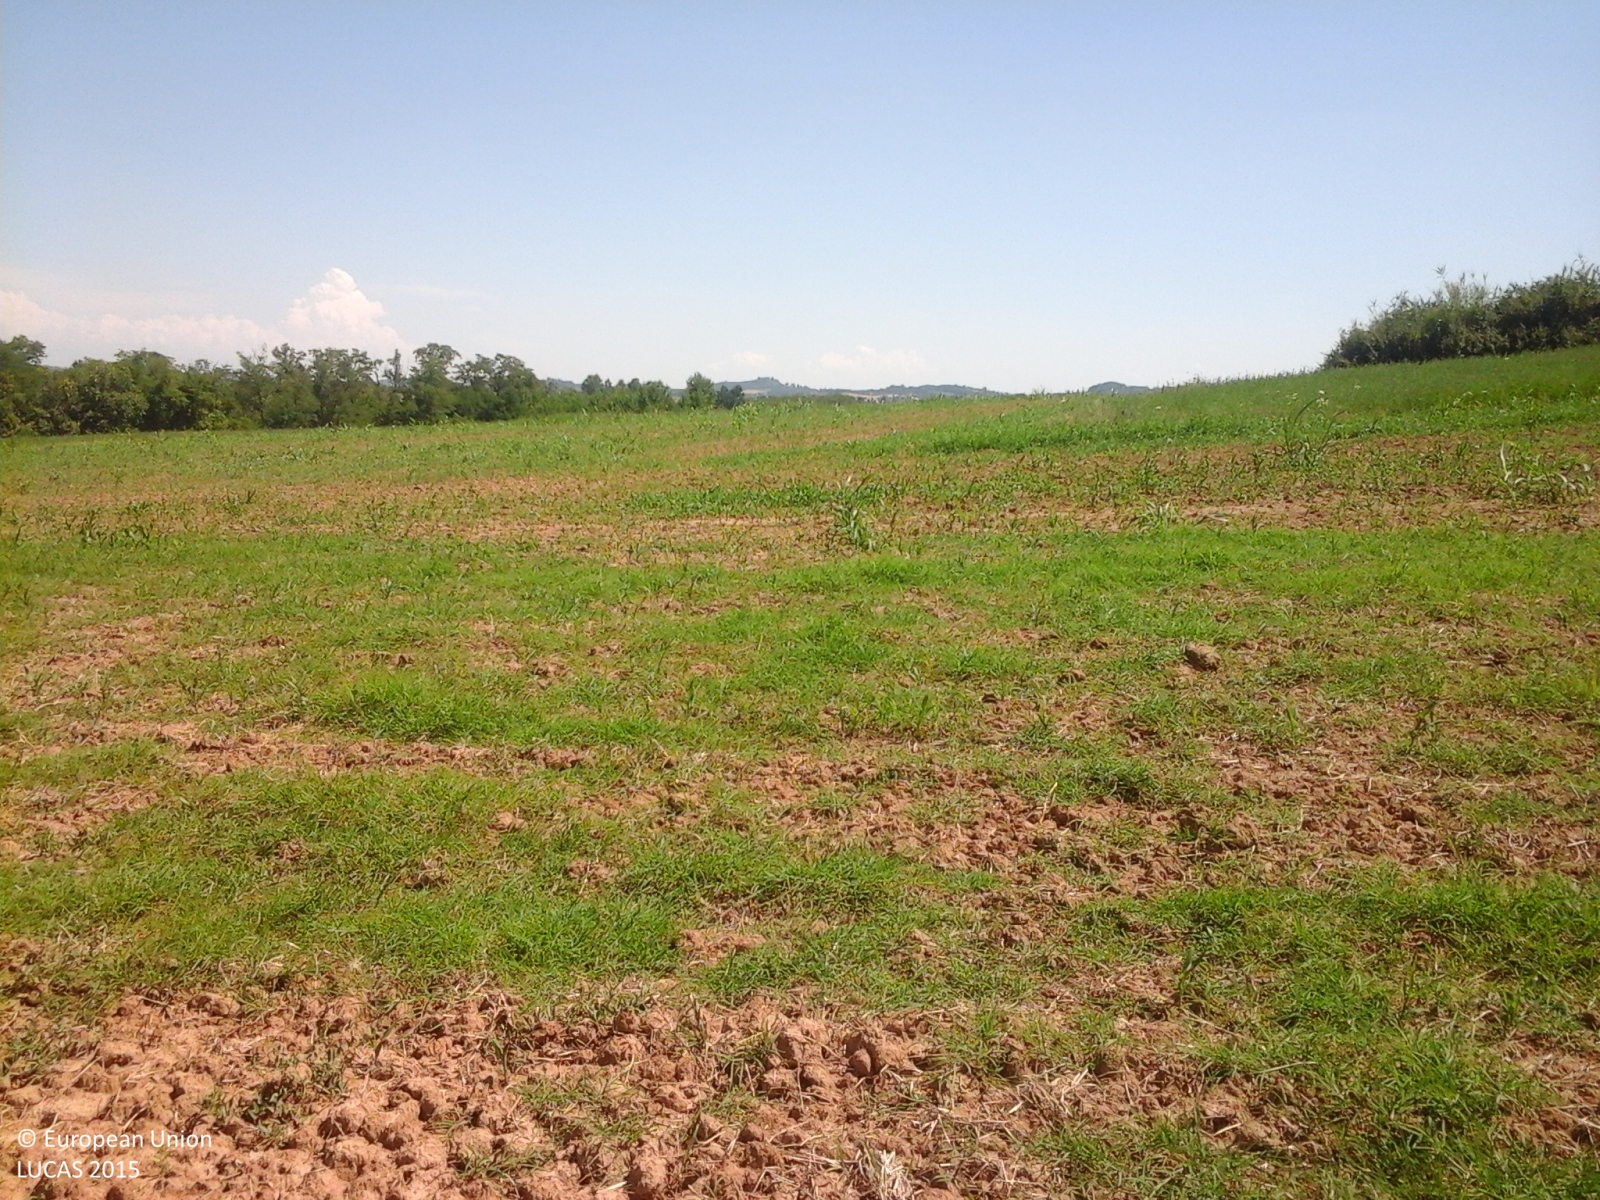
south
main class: Grassland
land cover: Grassland without tree/shrub cover
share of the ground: 50 - 75 %
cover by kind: herbaceous plants 65 %, unconsolidated bare surface 35 %
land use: Agriculture (excluding fallow land and kitchen gardens)
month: June
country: IT
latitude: 45.0444
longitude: 8.5934
